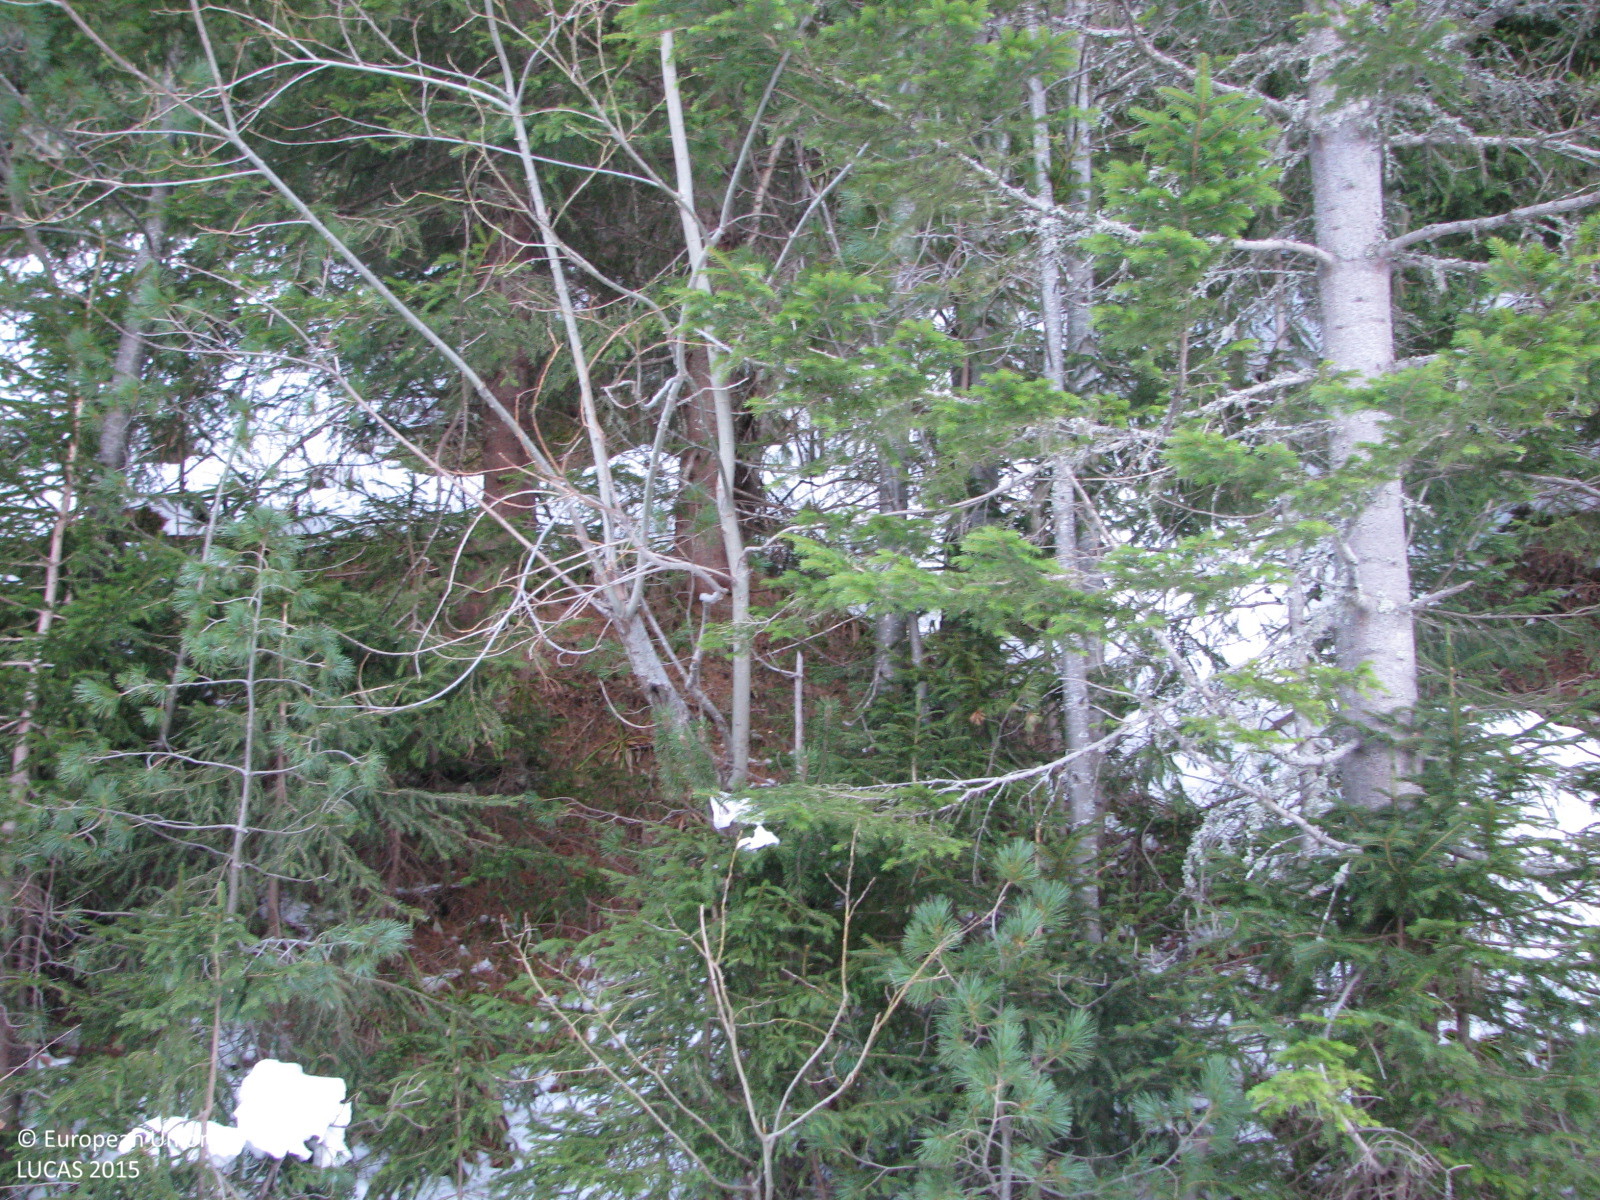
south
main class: Woodland
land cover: Spruce dominated mixed woodland
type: hemiboreal forest and nemoral coniferous forest and mixed broadleaved-coniferous forest
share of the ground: > 75 %
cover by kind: coniferous forest trees 60 %, broadleaved forest trees 25 %, unconsolidated bare surface 15 %
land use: Forestry
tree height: < 5 m
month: December
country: BG
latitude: 42.1942
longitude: 23.8296
